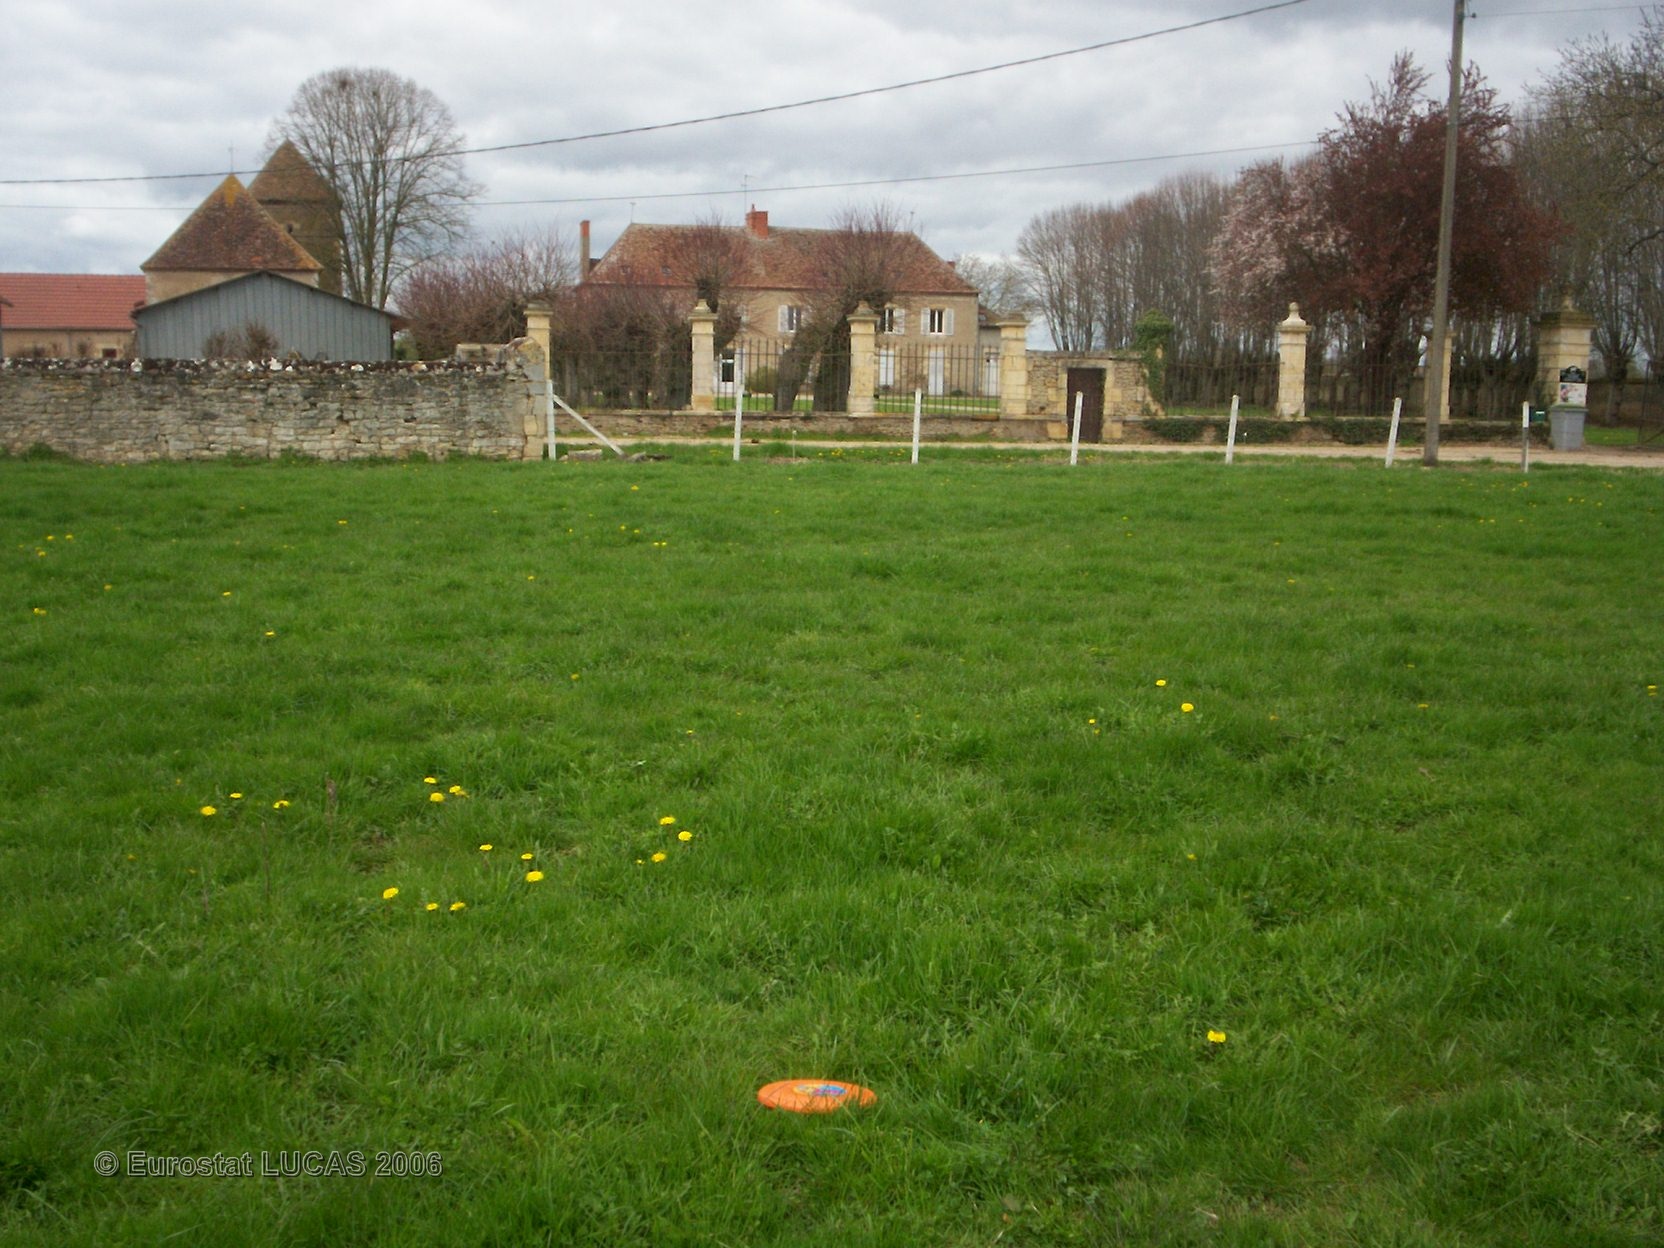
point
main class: Grassland
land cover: Grassland without tree/shrub cover
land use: Agriculture (excluding fallow land and kitchen gardens)
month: April
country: FR
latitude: 46.7931
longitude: 3.0399
